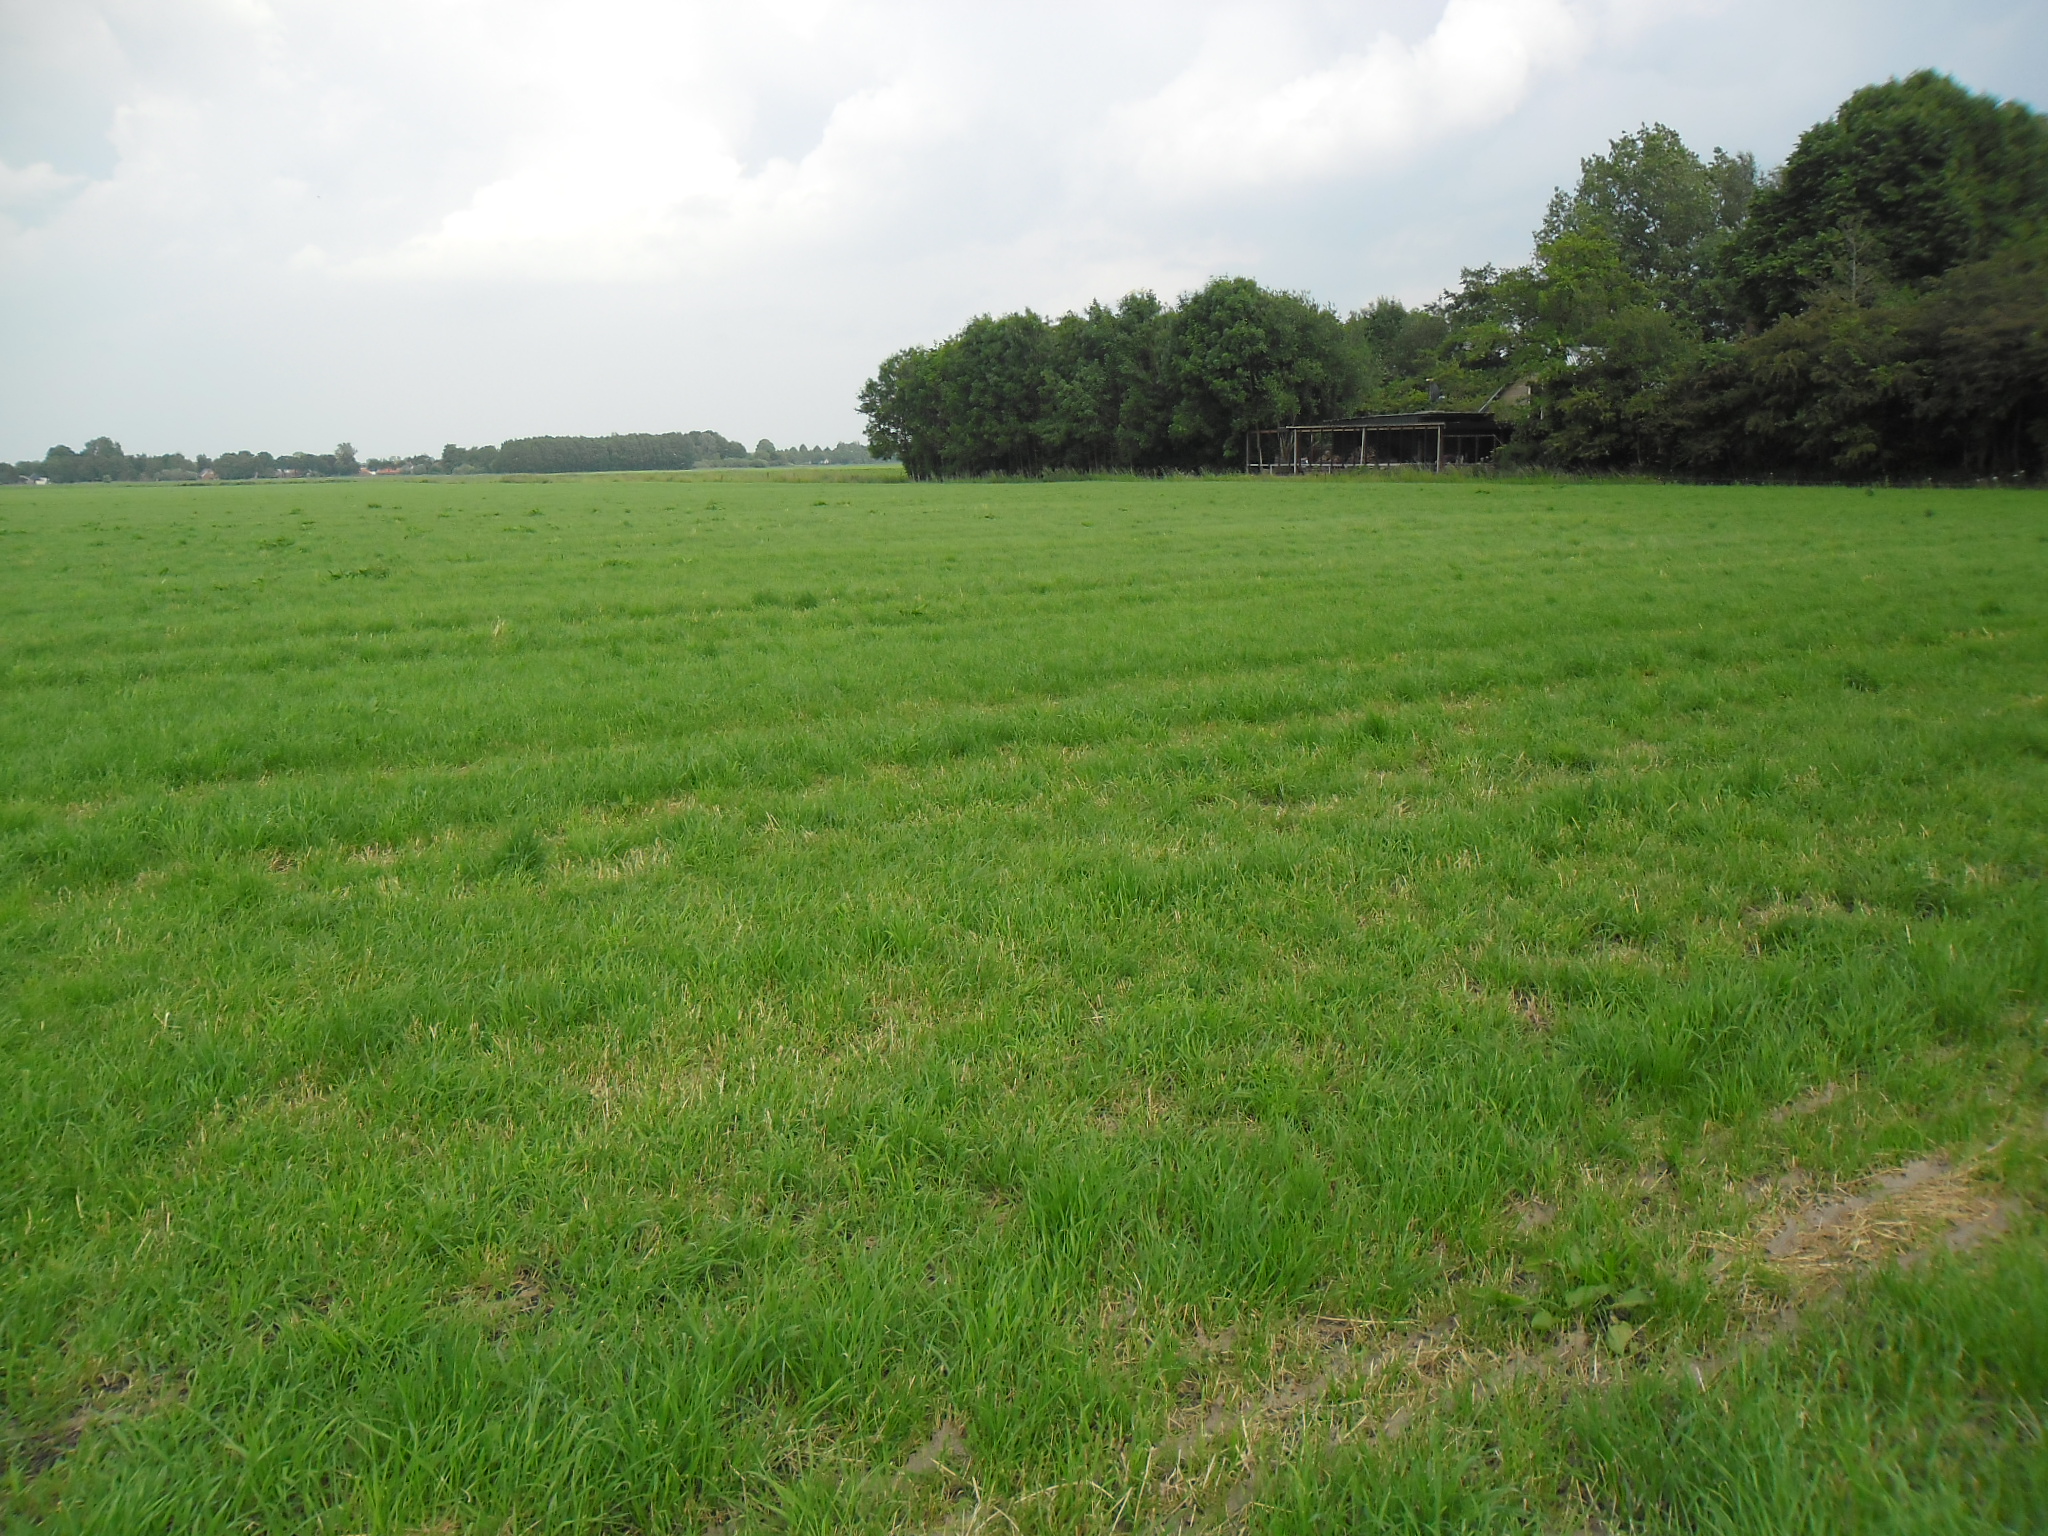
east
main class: Grassland
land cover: Grassland without tree/shrub cover
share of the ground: > 75 %
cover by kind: herbaceous plants 100 %
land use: Agriculture (excluding fallow land and kitchen gardens)
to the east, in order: Grassland without tree/shrub cover; Electric lines; Inland fresh running water; Maize
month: June
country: NL
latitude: 53.1770
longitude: 6.6936
